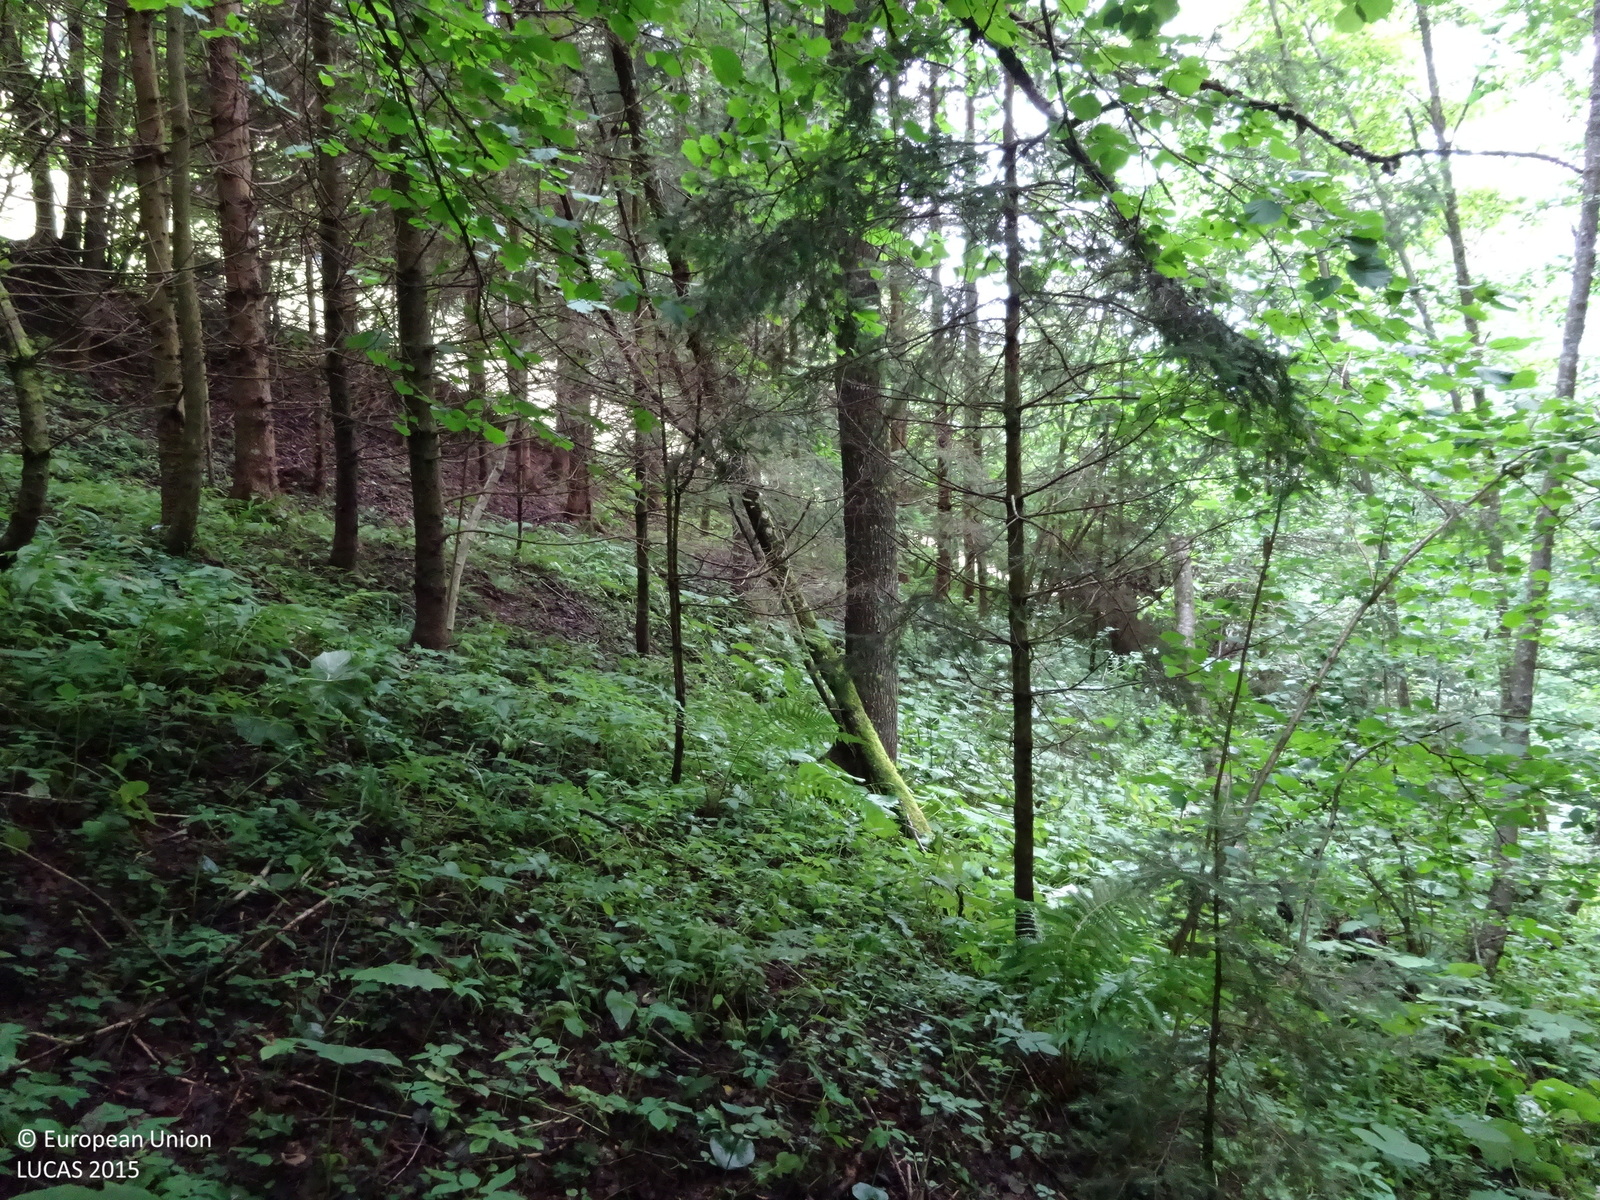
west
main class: Woodland
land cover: Spruce dominated mixed woodland
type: mountainous beech forest
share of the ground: > 75 %
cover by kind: broadleaved forest trees 65 %, coniferous forest trees 25 %, shrubs 10 %
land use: Forestry
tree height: > 5 m
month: July
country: AT
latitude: 47.2380
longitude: 15.5089
